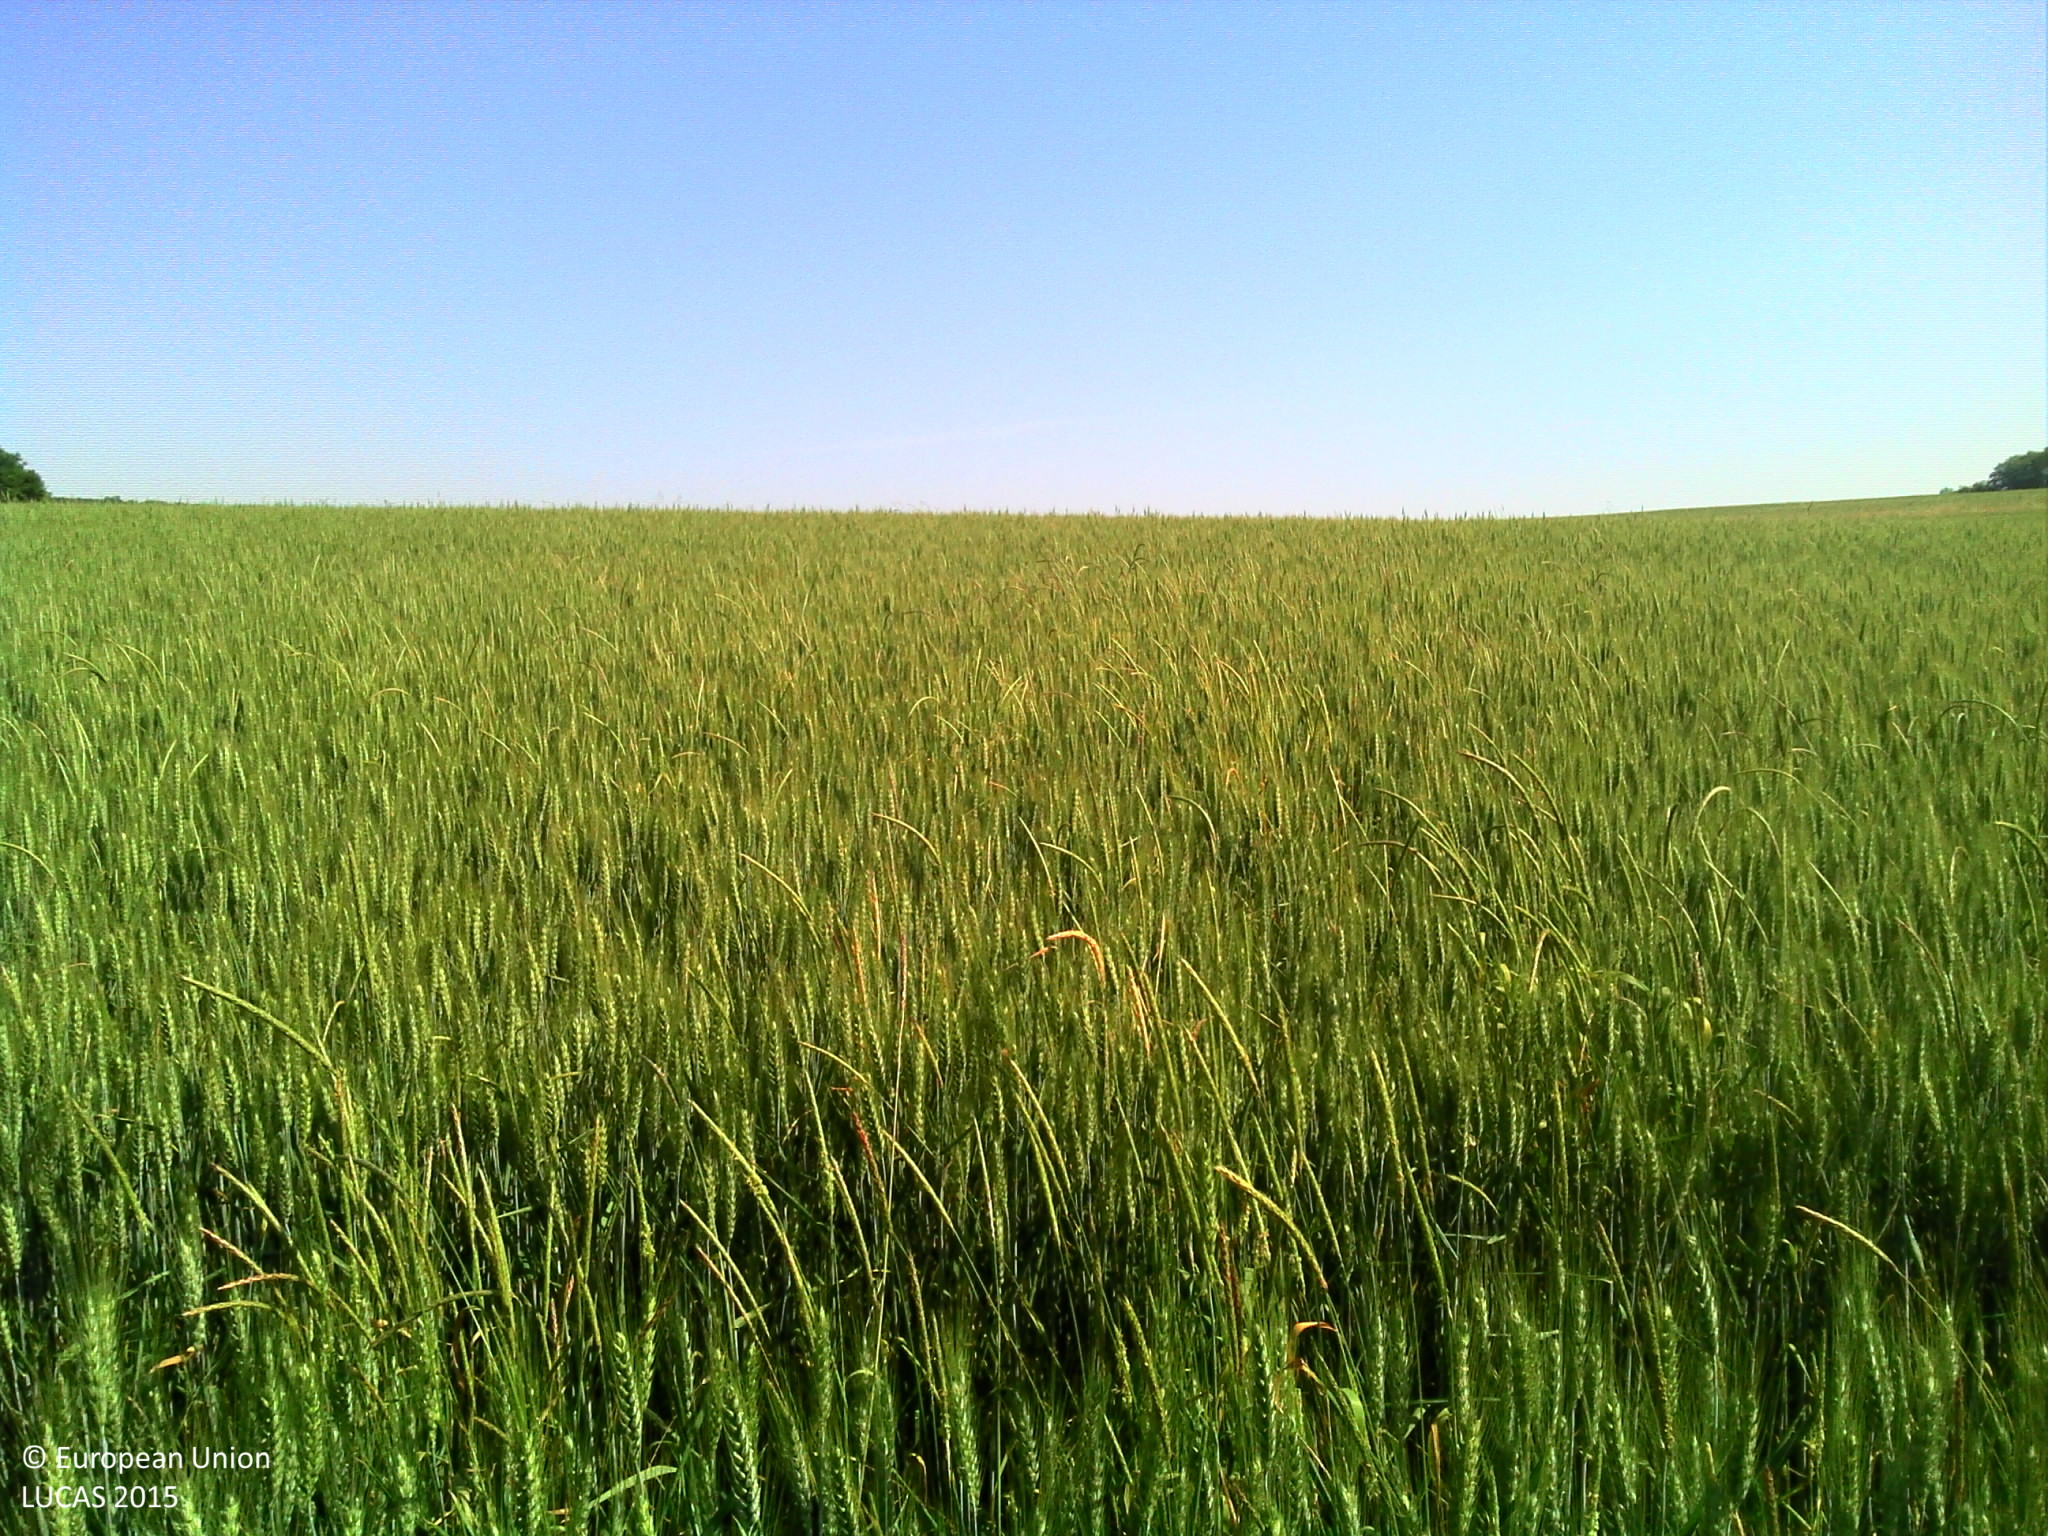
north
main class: Cropland
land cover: Durum wheat
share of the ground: > 75 %
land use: Agriculture (excluding fallow land and kitchen gardens)
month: June
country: FR
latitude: 47.5792
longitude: 6.1324
